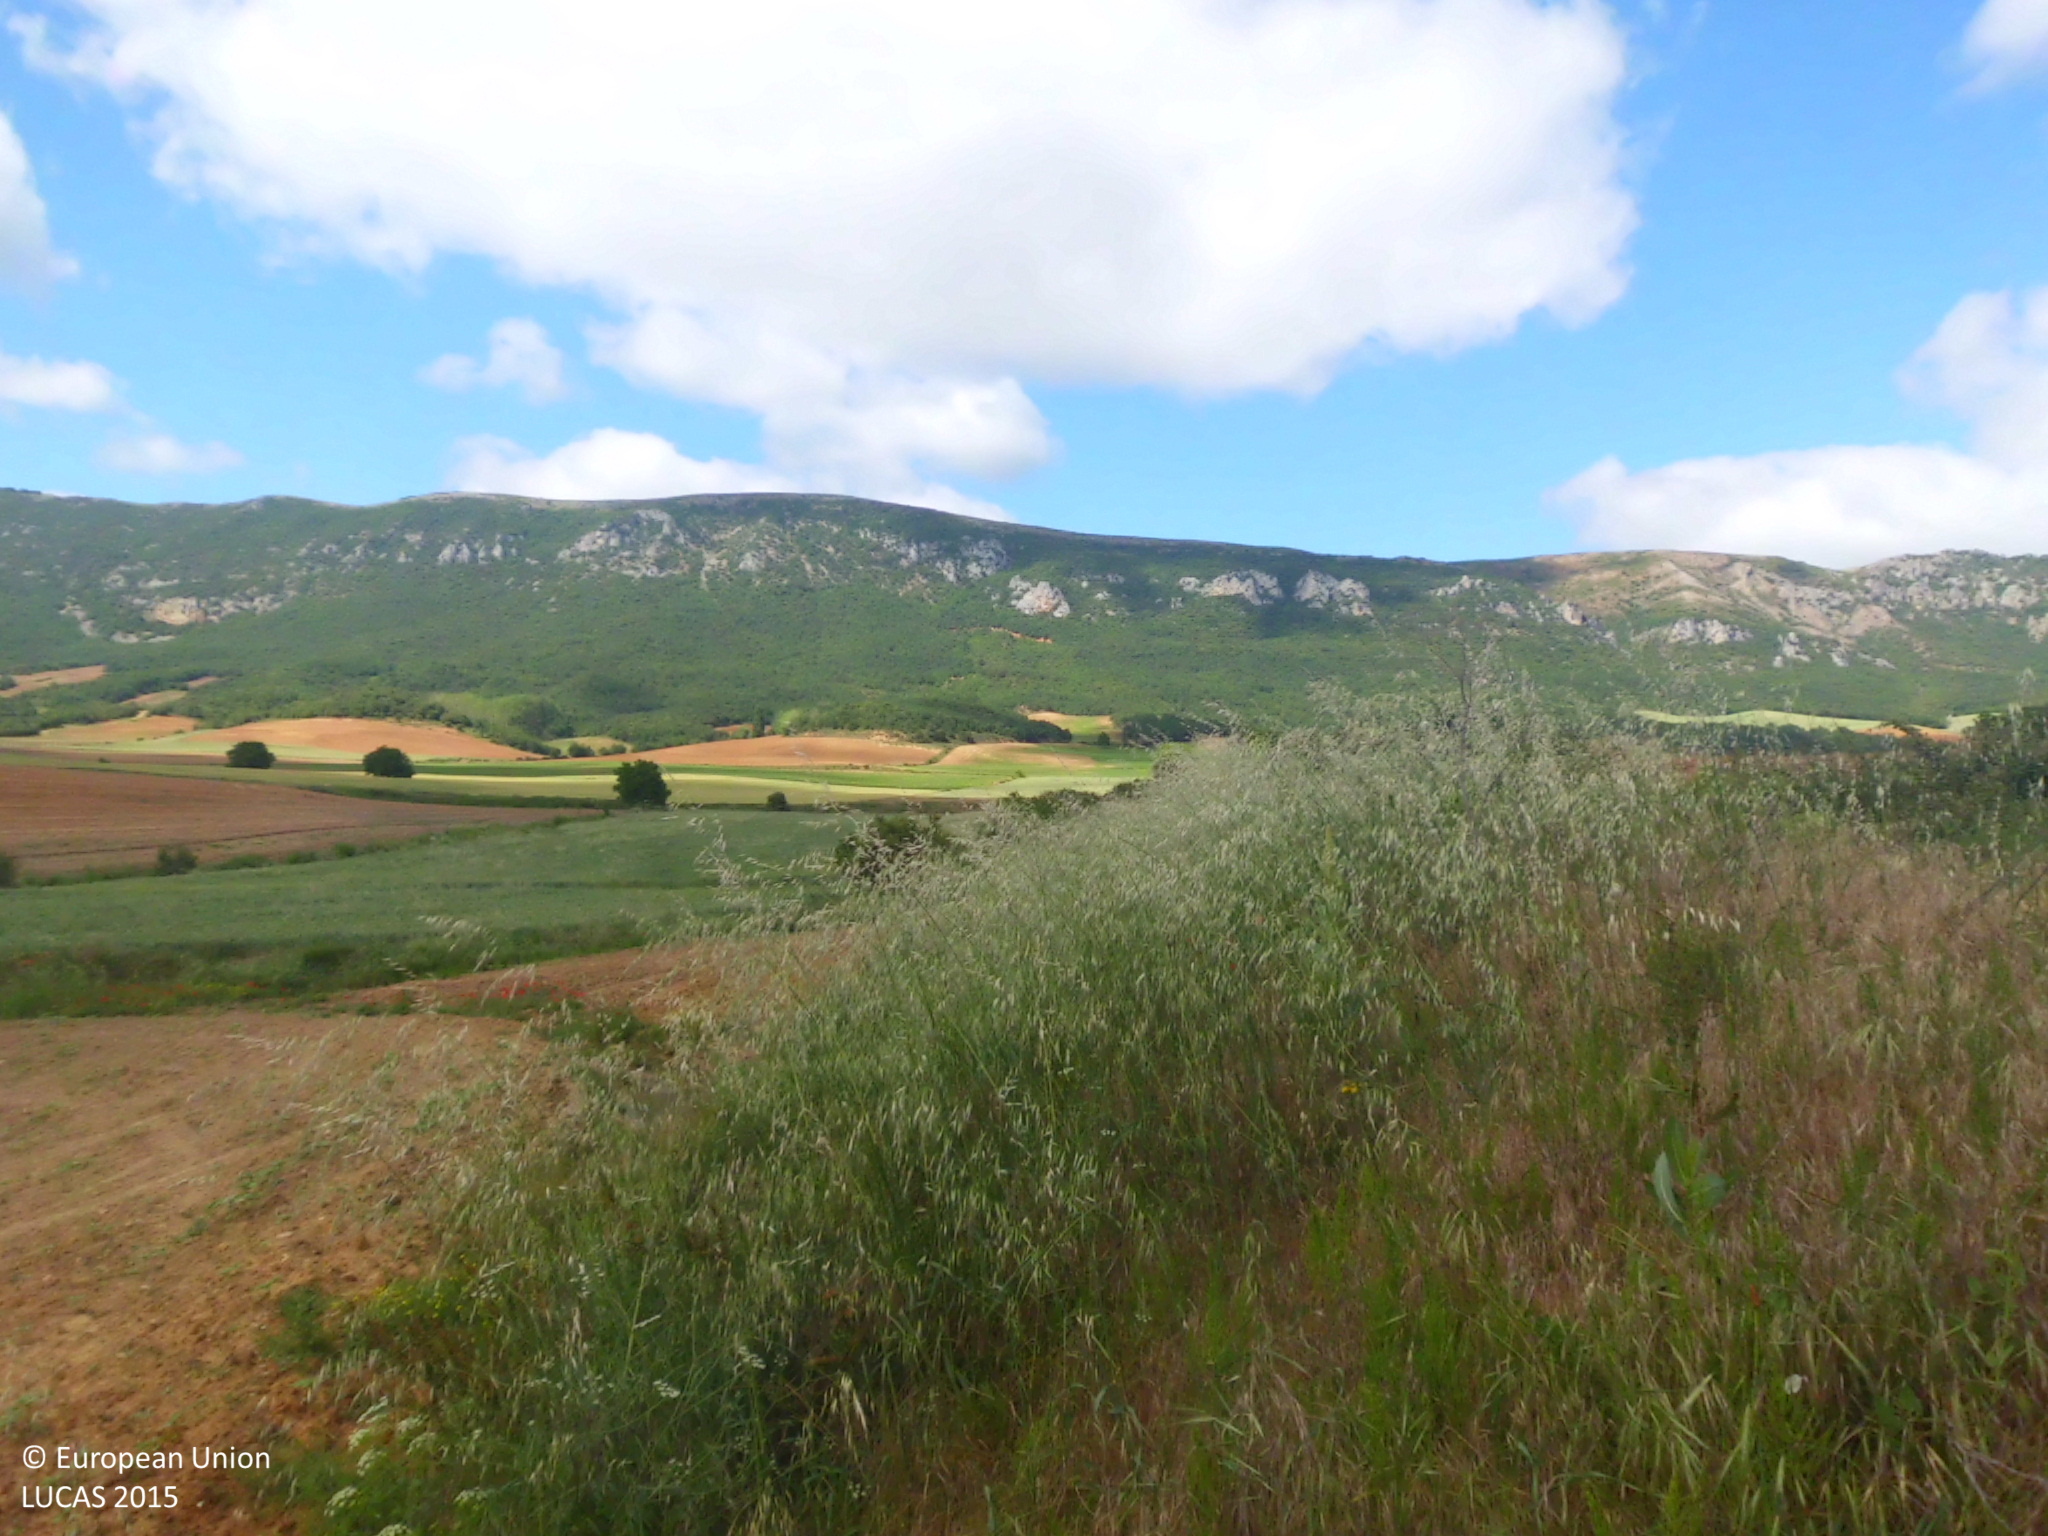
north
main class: Grassland
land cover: Grassland with sparse tree/shrub cover
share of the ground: > 75 %
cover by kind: herbaceous plants 80 %, consolidated bare surface 15 %, broadleaved forest trees 5 %
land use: Agriculture (excluding fallow land and kitchen gardens)
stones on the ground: < 10 %
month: June
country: ES
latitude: 42.6799
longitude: -3.3486
